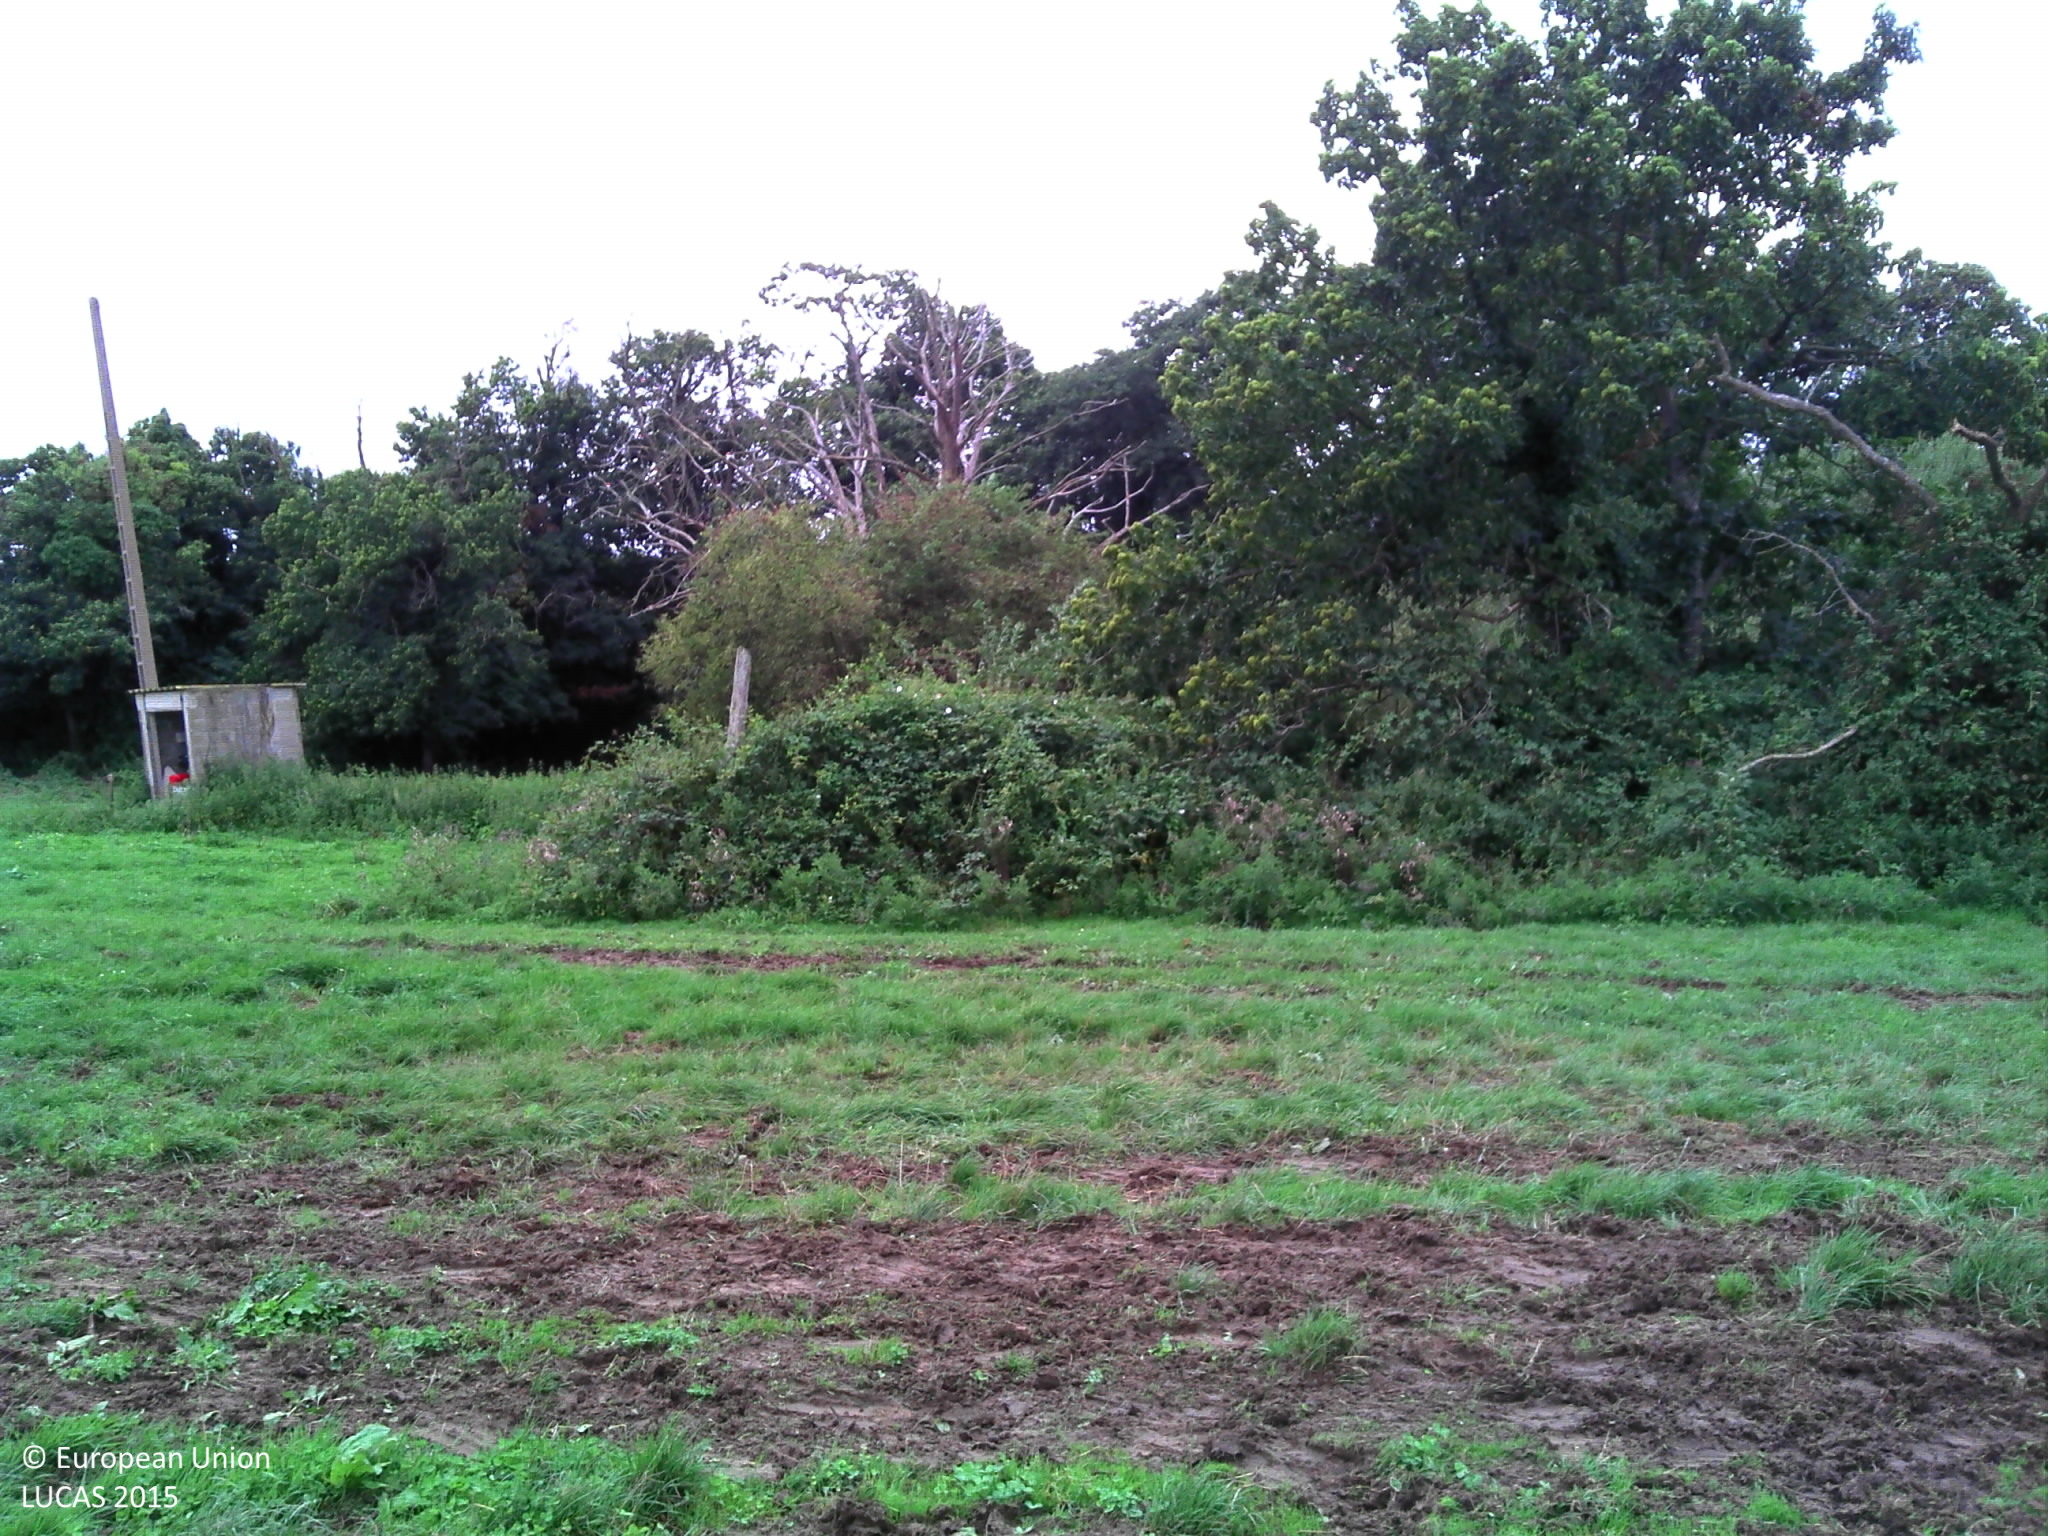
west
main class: Grassland
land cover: Grassland without tree/shrub cover
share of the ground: > 75 %
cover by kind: herbaceous plants 90 %, unconsolidated bare surface 10 %
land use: Agriculture (excluding fallow land and kitchen gardens)
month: August
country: FR
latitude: 48.5725
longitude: -2.1045
